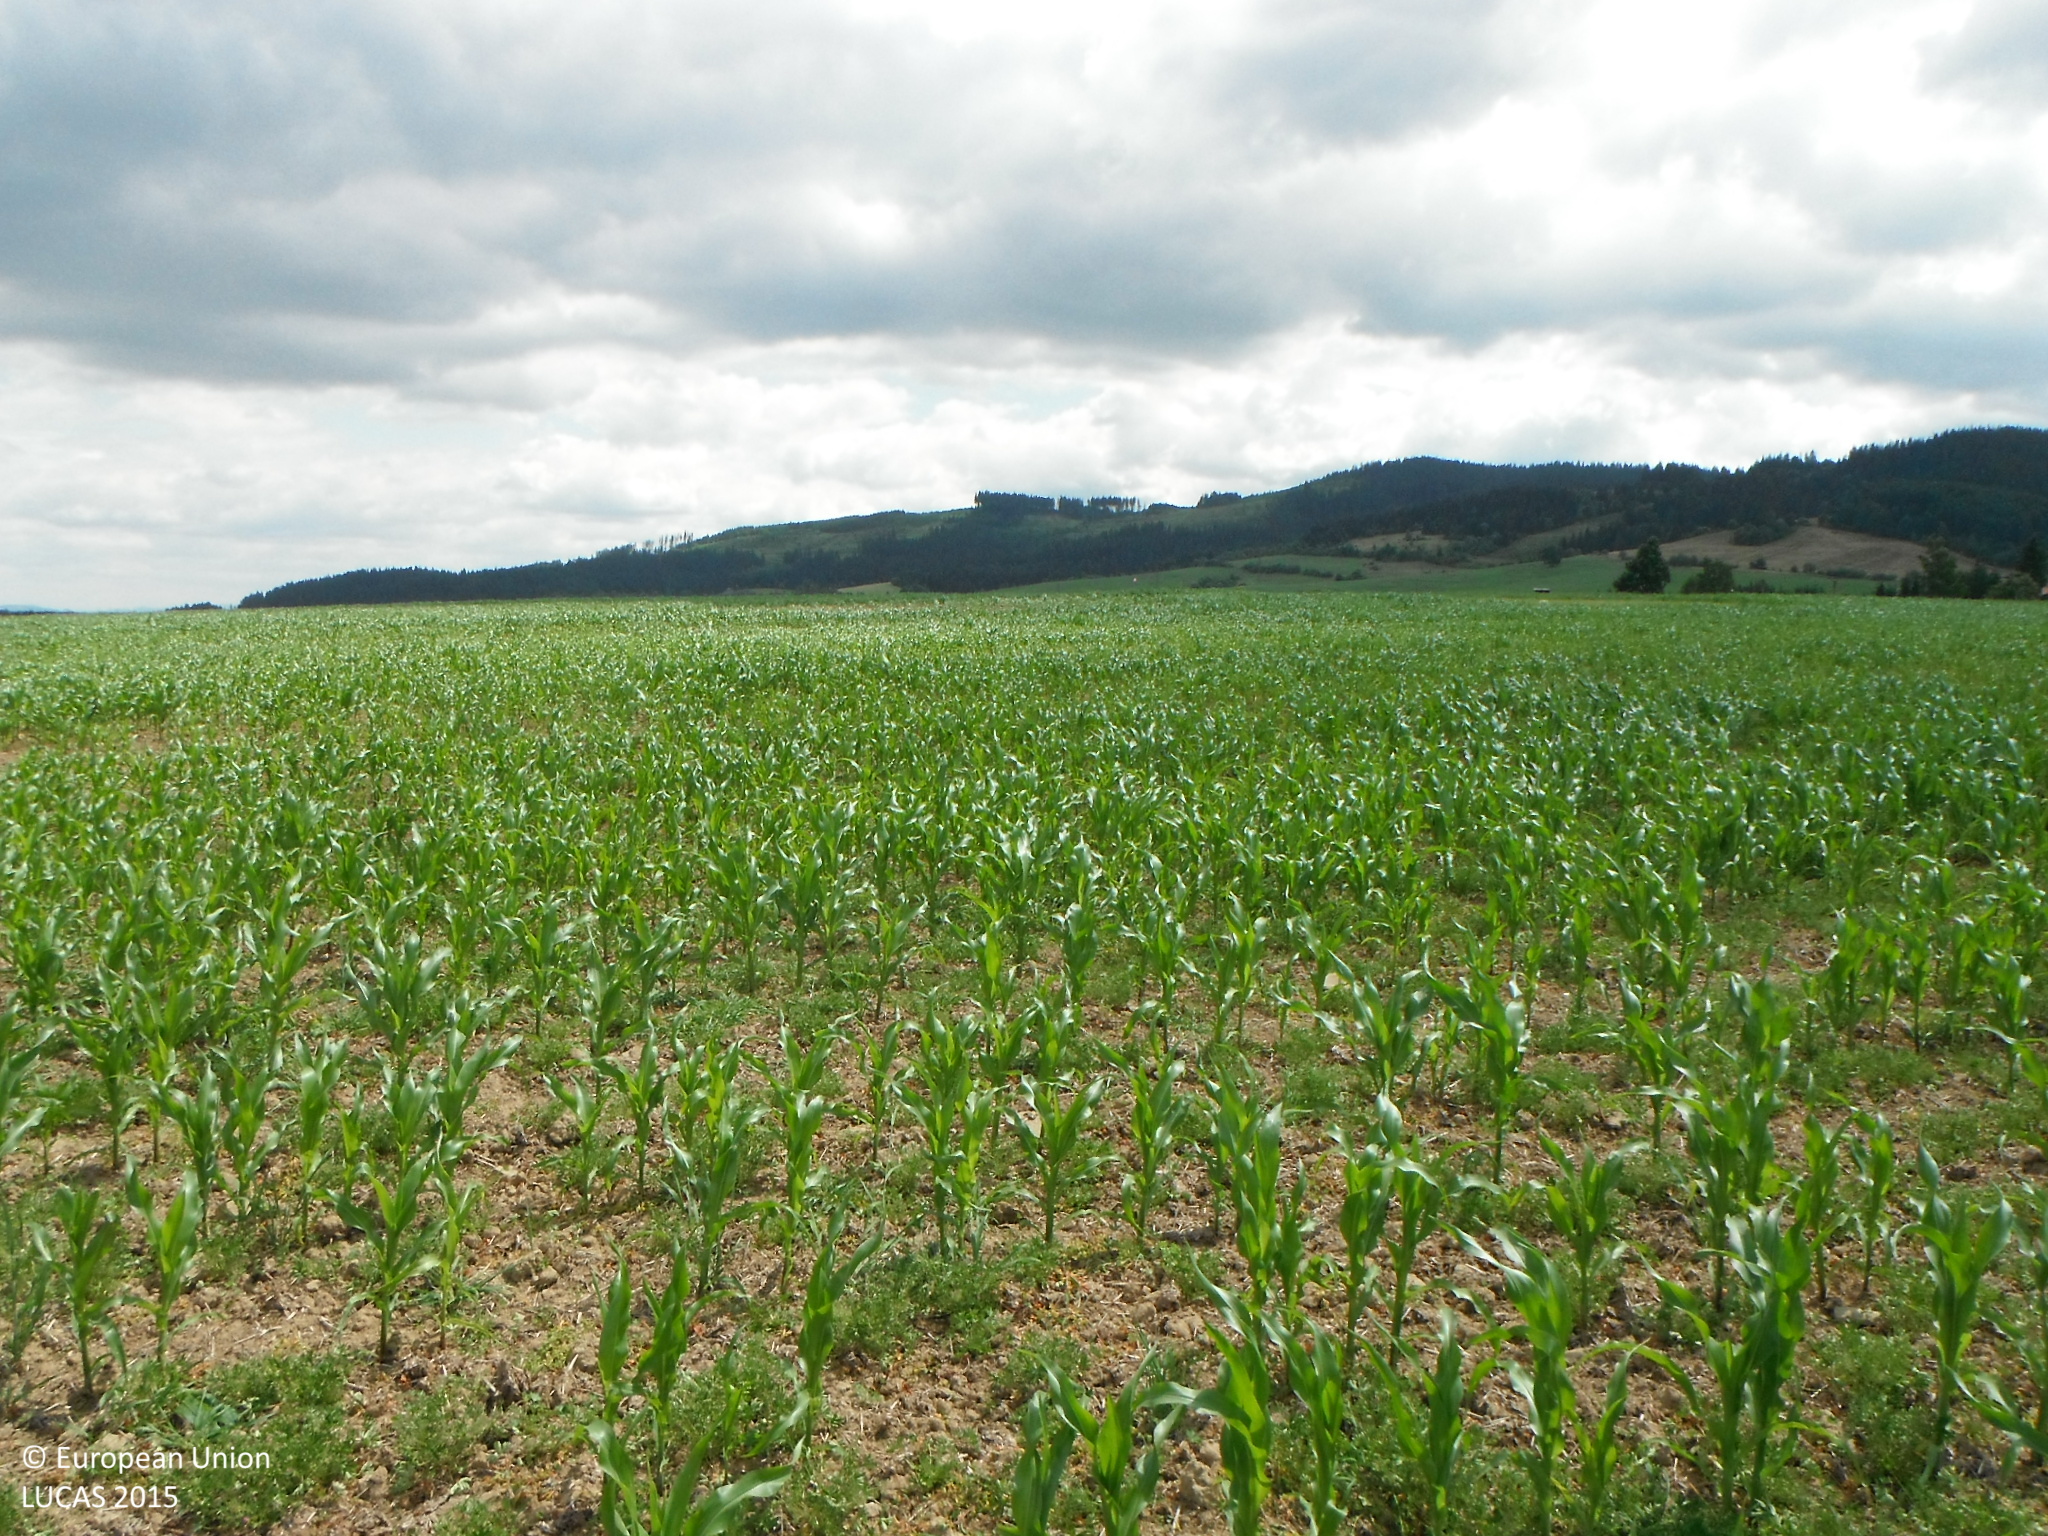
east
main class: Cropland
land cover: Maize
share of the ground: 25 - 50 %
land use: Agriculture (excluding fallow land and kitchen gardens)
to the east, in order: Maize
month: July
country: SK
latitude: 49.3914
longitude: 19.4637
